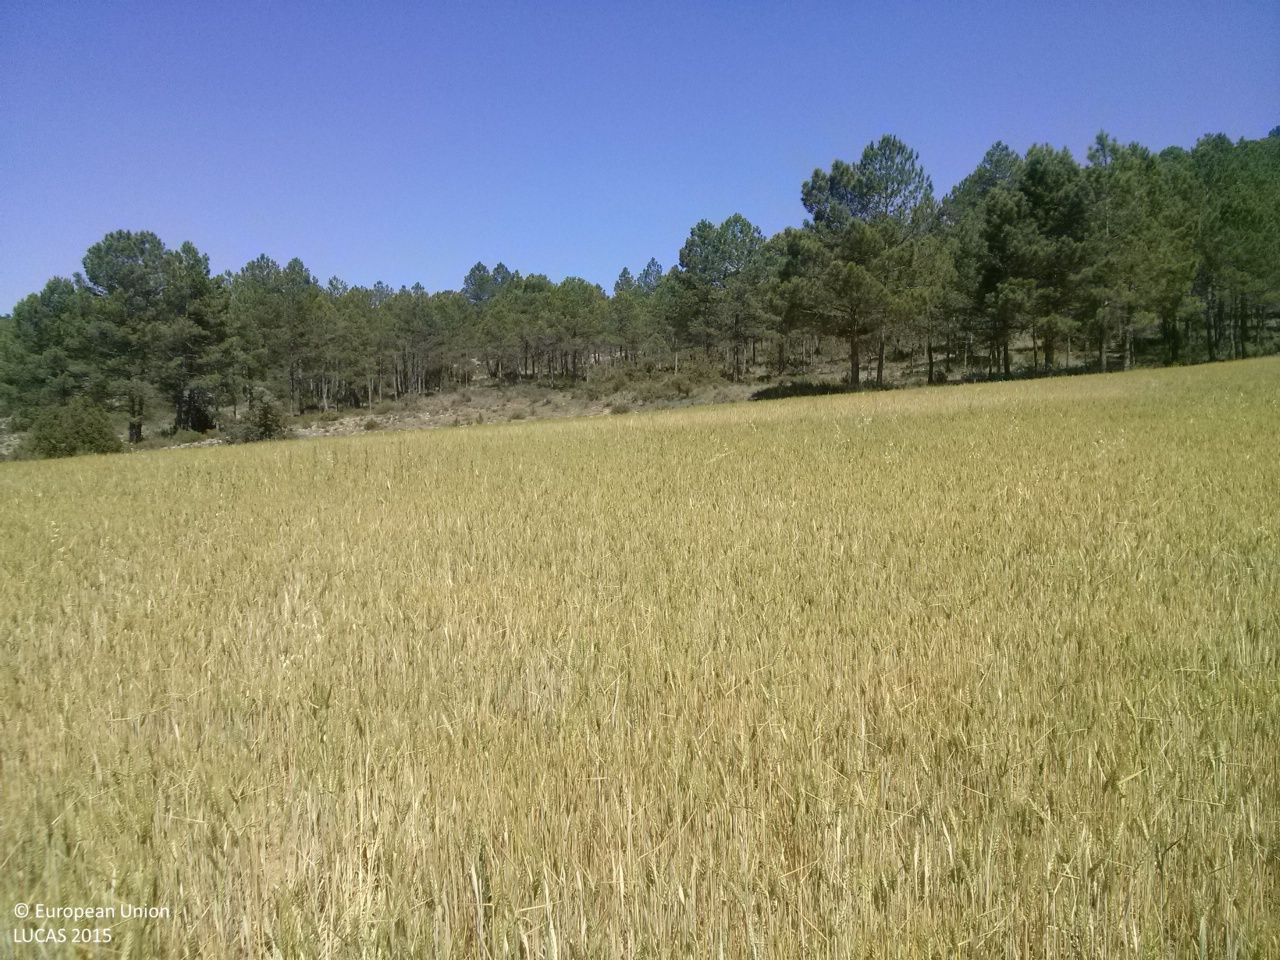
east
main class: Cropland
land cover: Common wheat
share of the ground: > 75 %
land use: Agriculture (excluding fallow land and kitchen gardens)
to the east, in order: Common wheat; Pine dominated coniferous woodland; Grassland without tree/shrub cover; Shrubland with sparse tree cover
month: June
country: ES
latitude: 39.7976
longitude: -1.8878
